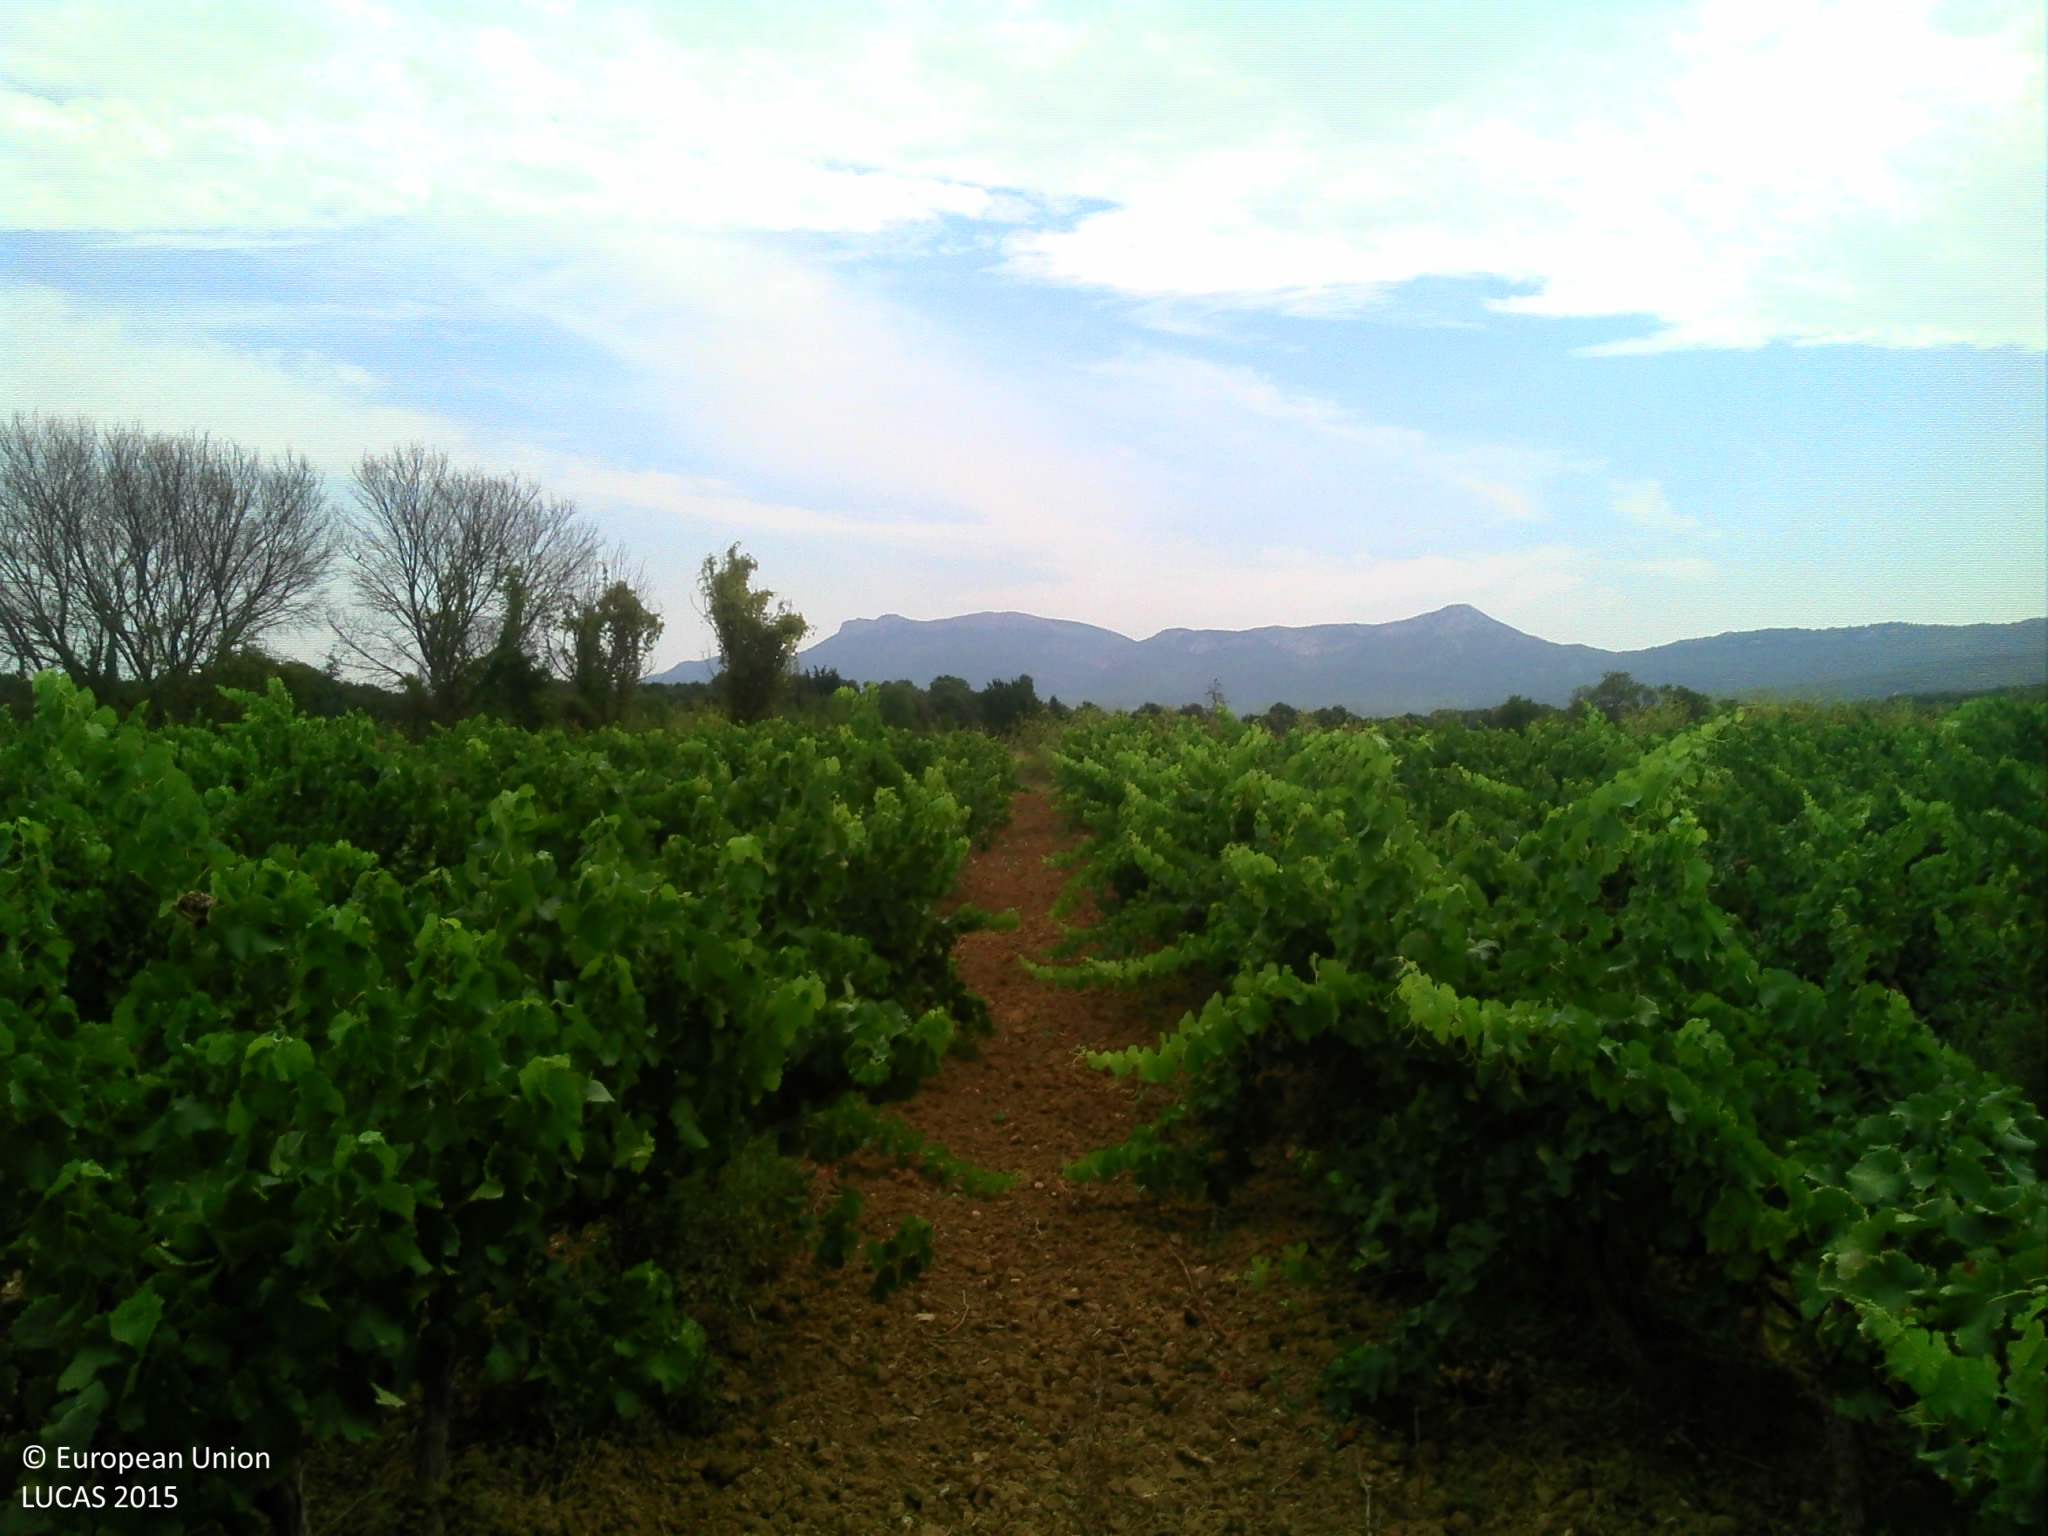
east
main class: Cropland
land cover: Vineyards
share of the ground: > 75 %
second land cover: Other bare soil
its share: > 75 %
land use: Agriculture (excluding fallow land and kitchen gardens)
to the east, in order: Vineyards; Other bare soil; Tracks; Ditches and canals; Lines of trees; Spontaneously vegetated surfaces; Lines of trees; Shrubland without tree cover; Grassland with sparse tree/shrub cover
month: August
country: FR
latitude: 43.4643
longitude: 5.6465
